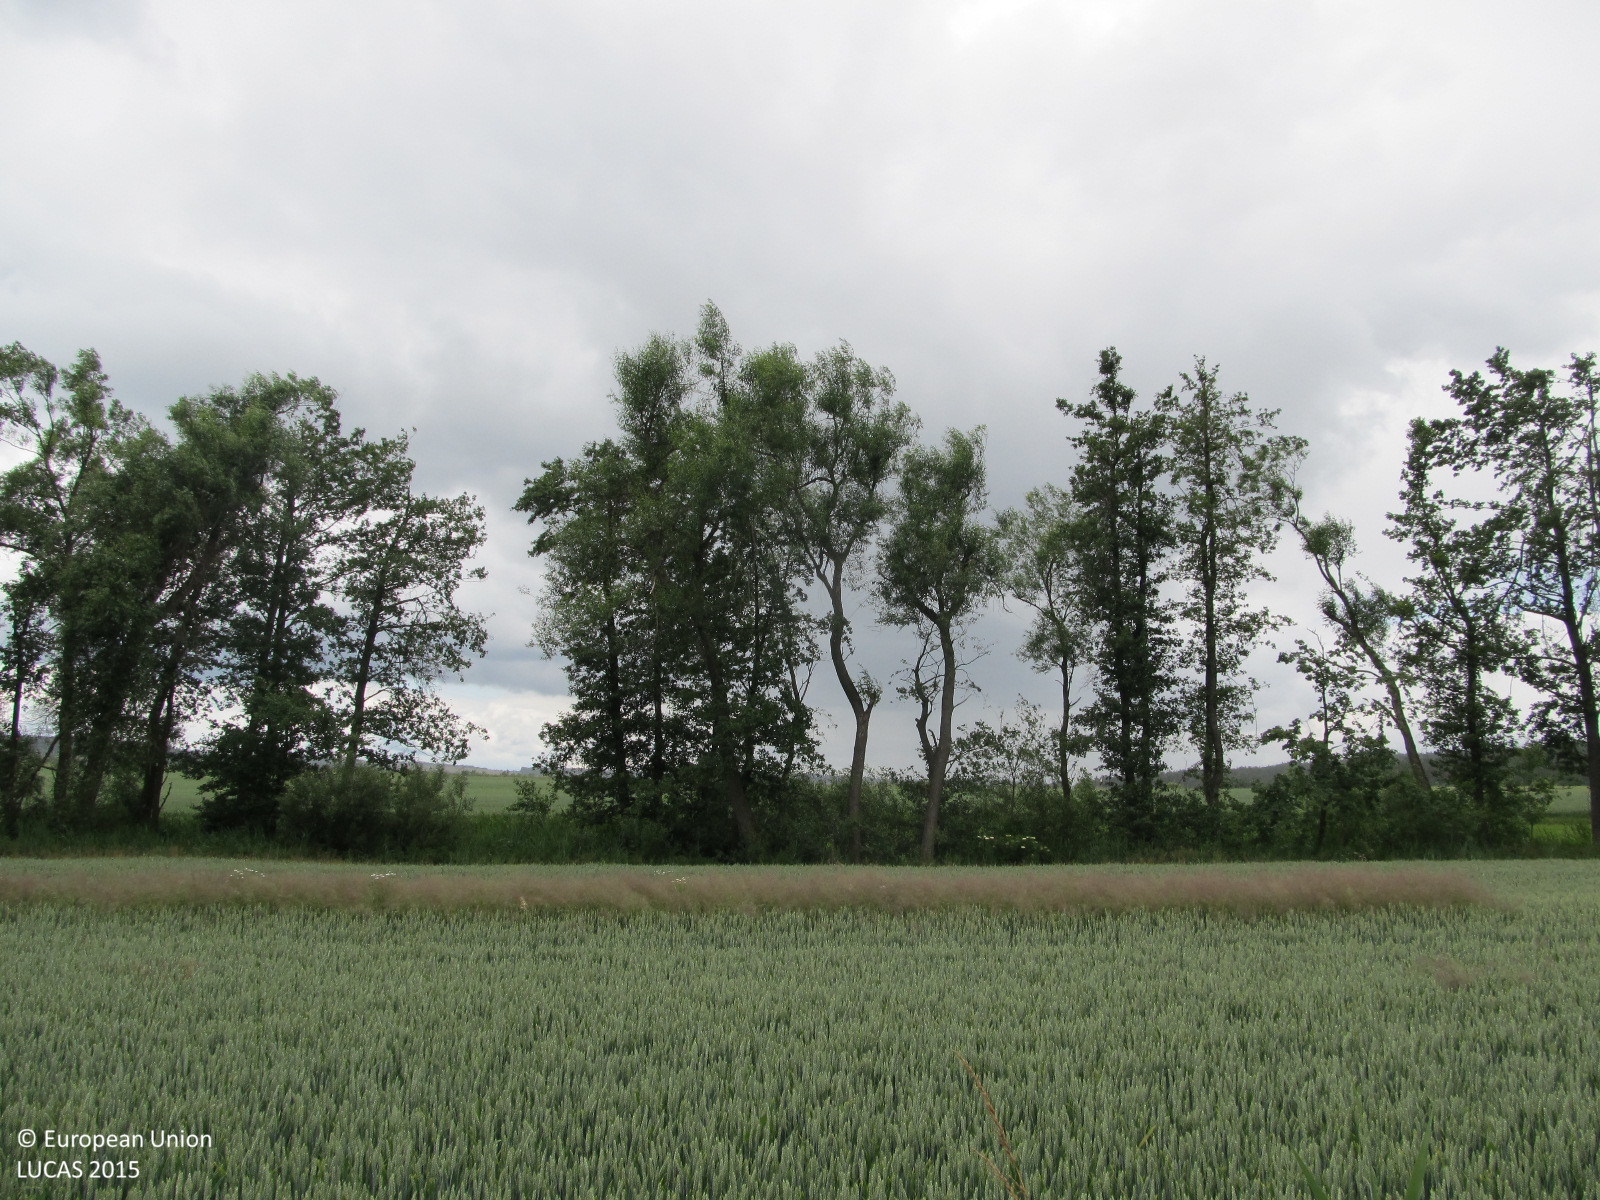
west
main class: Woodland
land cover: Broadleaved woodland
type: floodplain forest
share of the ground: > 75 %
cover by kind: broadleaved forest trees 80 %, shrubs 10 %, herbaceous plants 10 %
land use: Semi-natural and natural areas not in use
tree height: > 5 m
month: June
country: AT
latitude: 48.6480
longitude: 15.4457
